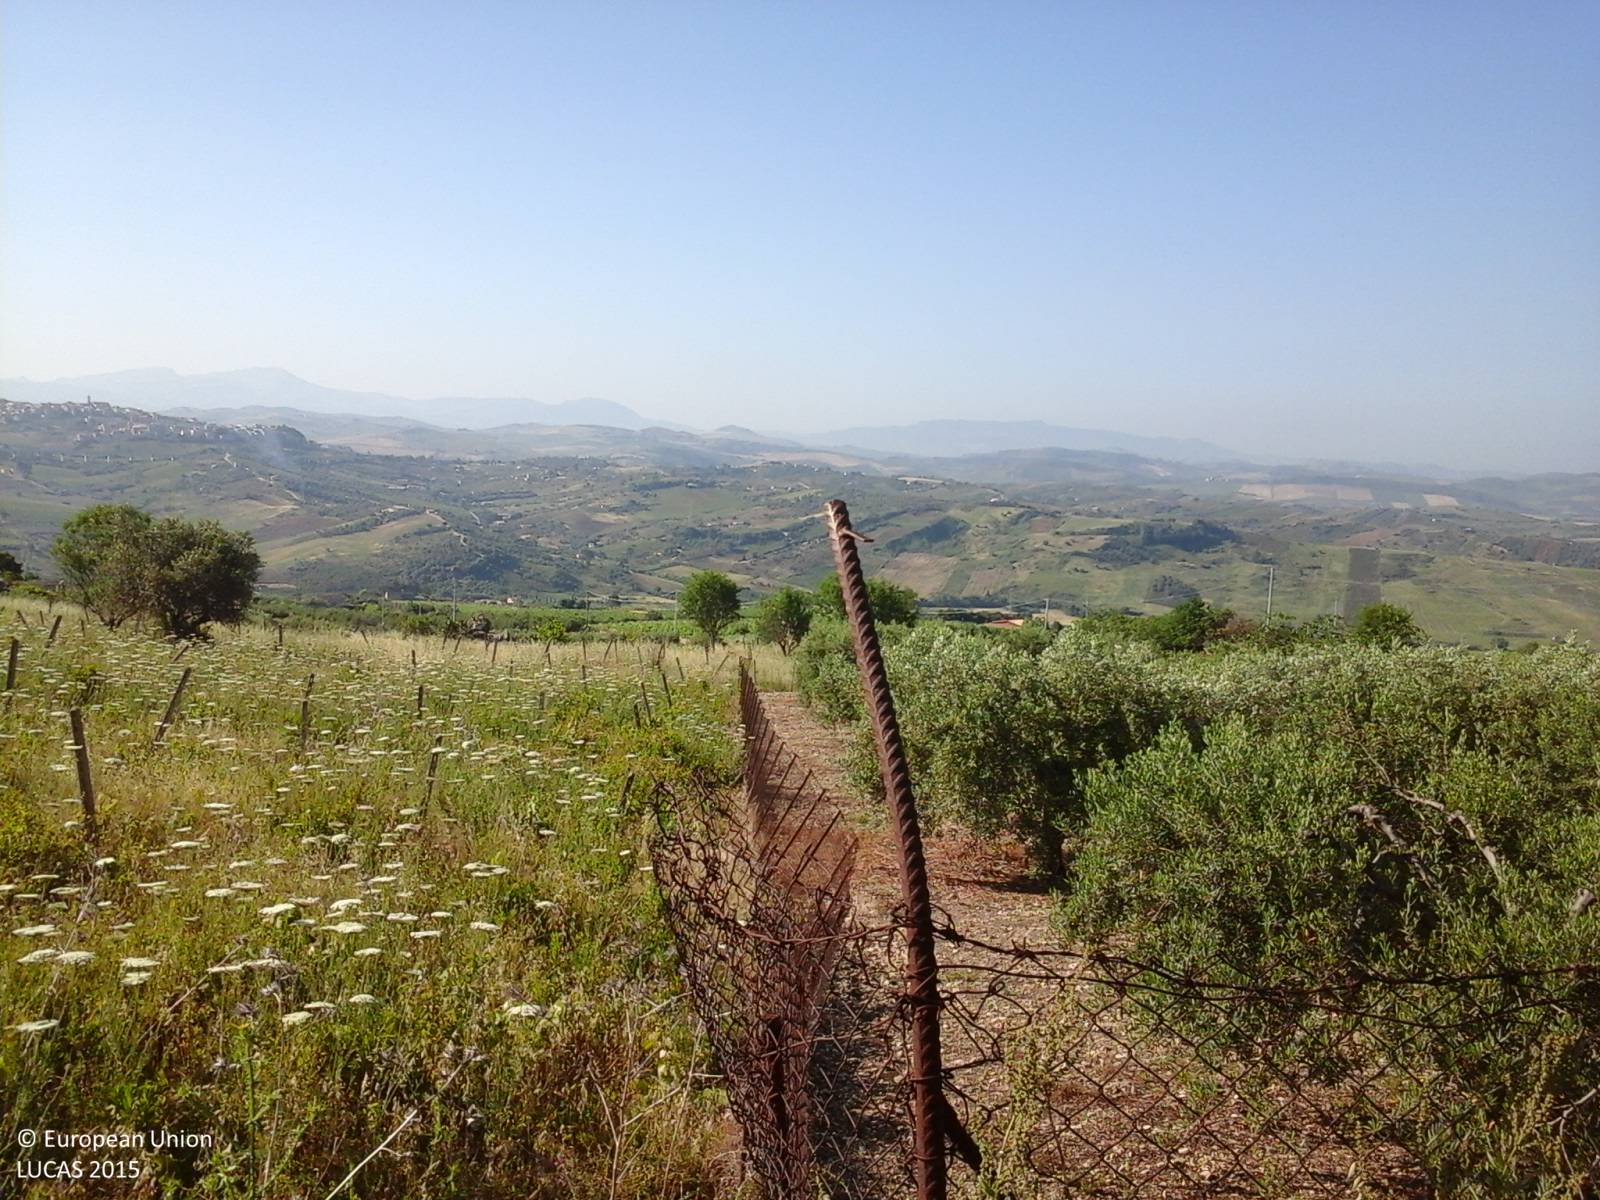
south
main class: Grassland
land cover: Grassland with sparse tree/shrub cover
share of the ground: > 75 %
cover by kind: herbaceous plants 95 %, broadleaved forest trees 5 %
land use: Abandoned areas
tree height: > 5 m
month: June
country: IT
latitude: 37.9859
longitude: 13.1540
